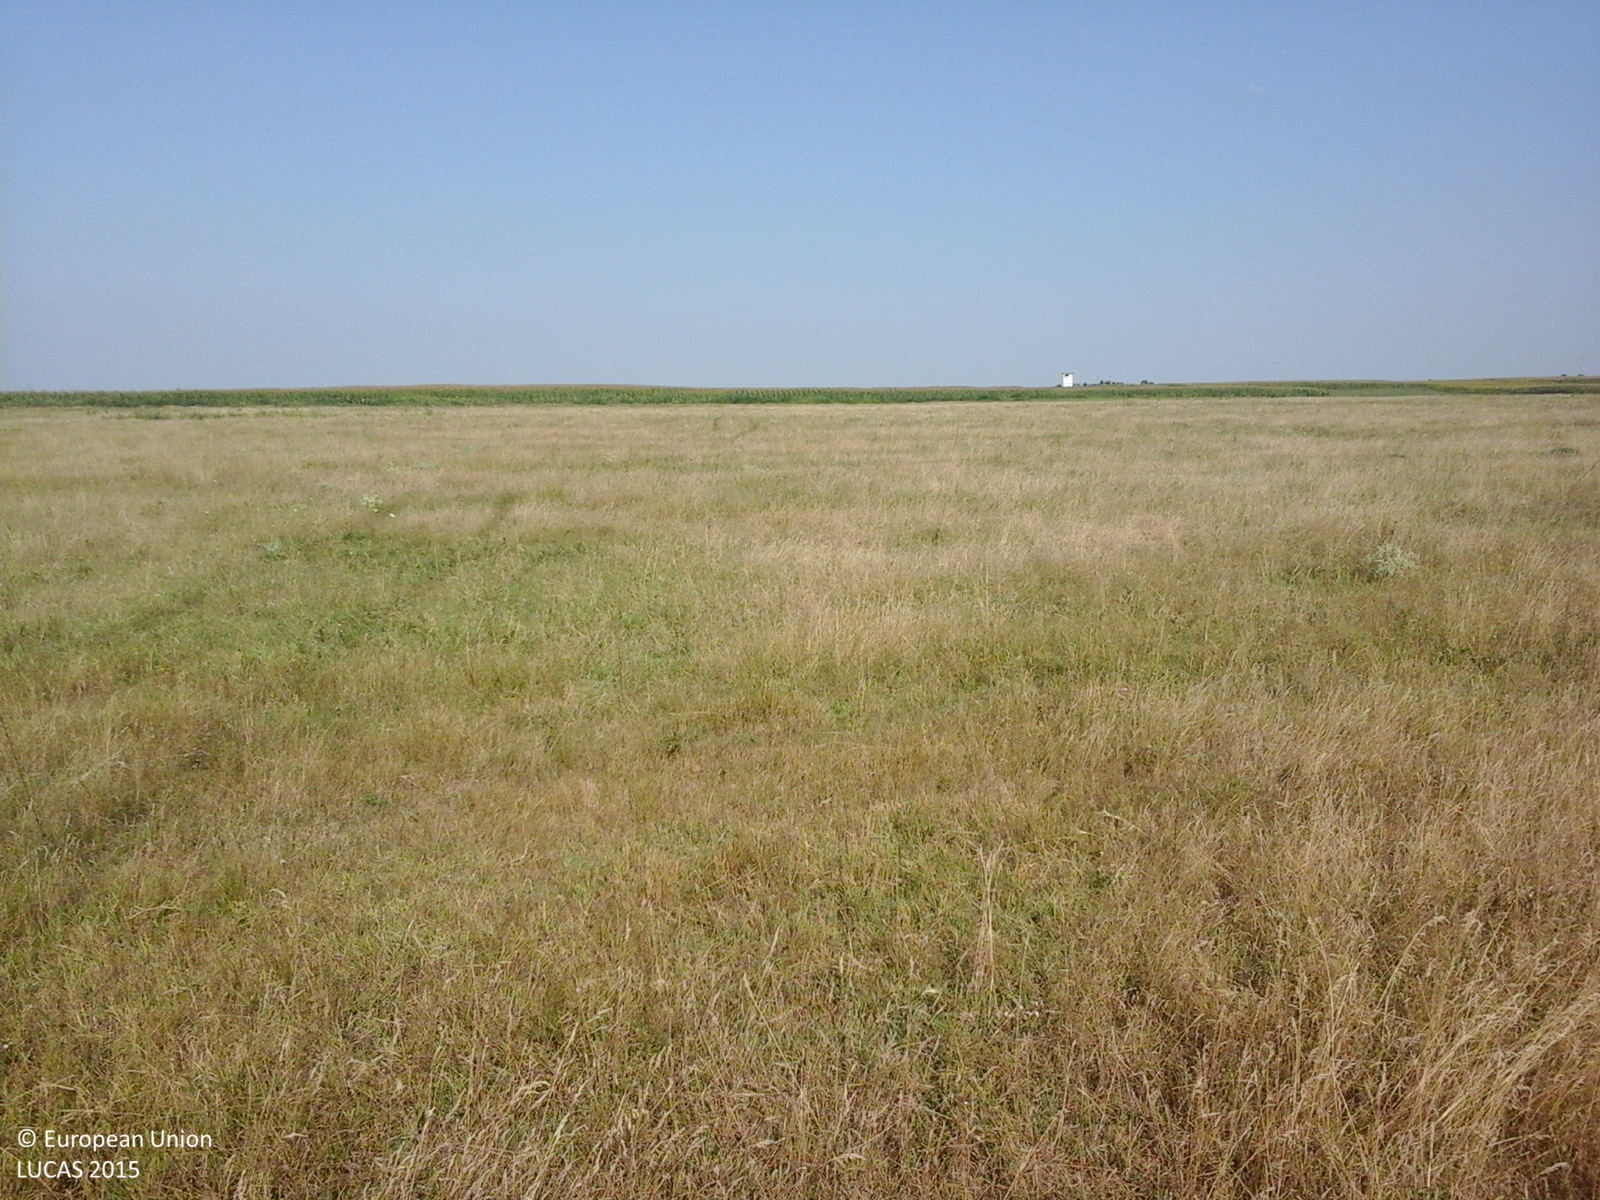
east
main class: Grassland
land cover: Grassland without tree/shrub cover
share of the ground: > 75 %
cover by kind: herbaceous plants 100 %
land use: Agriculture (excluding fallow land and kitchen gardens)
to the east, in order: Grassland without tree/shrub cover; Tracks; Maize
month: July
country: RO
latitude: 44.8387
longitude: 27.2817
